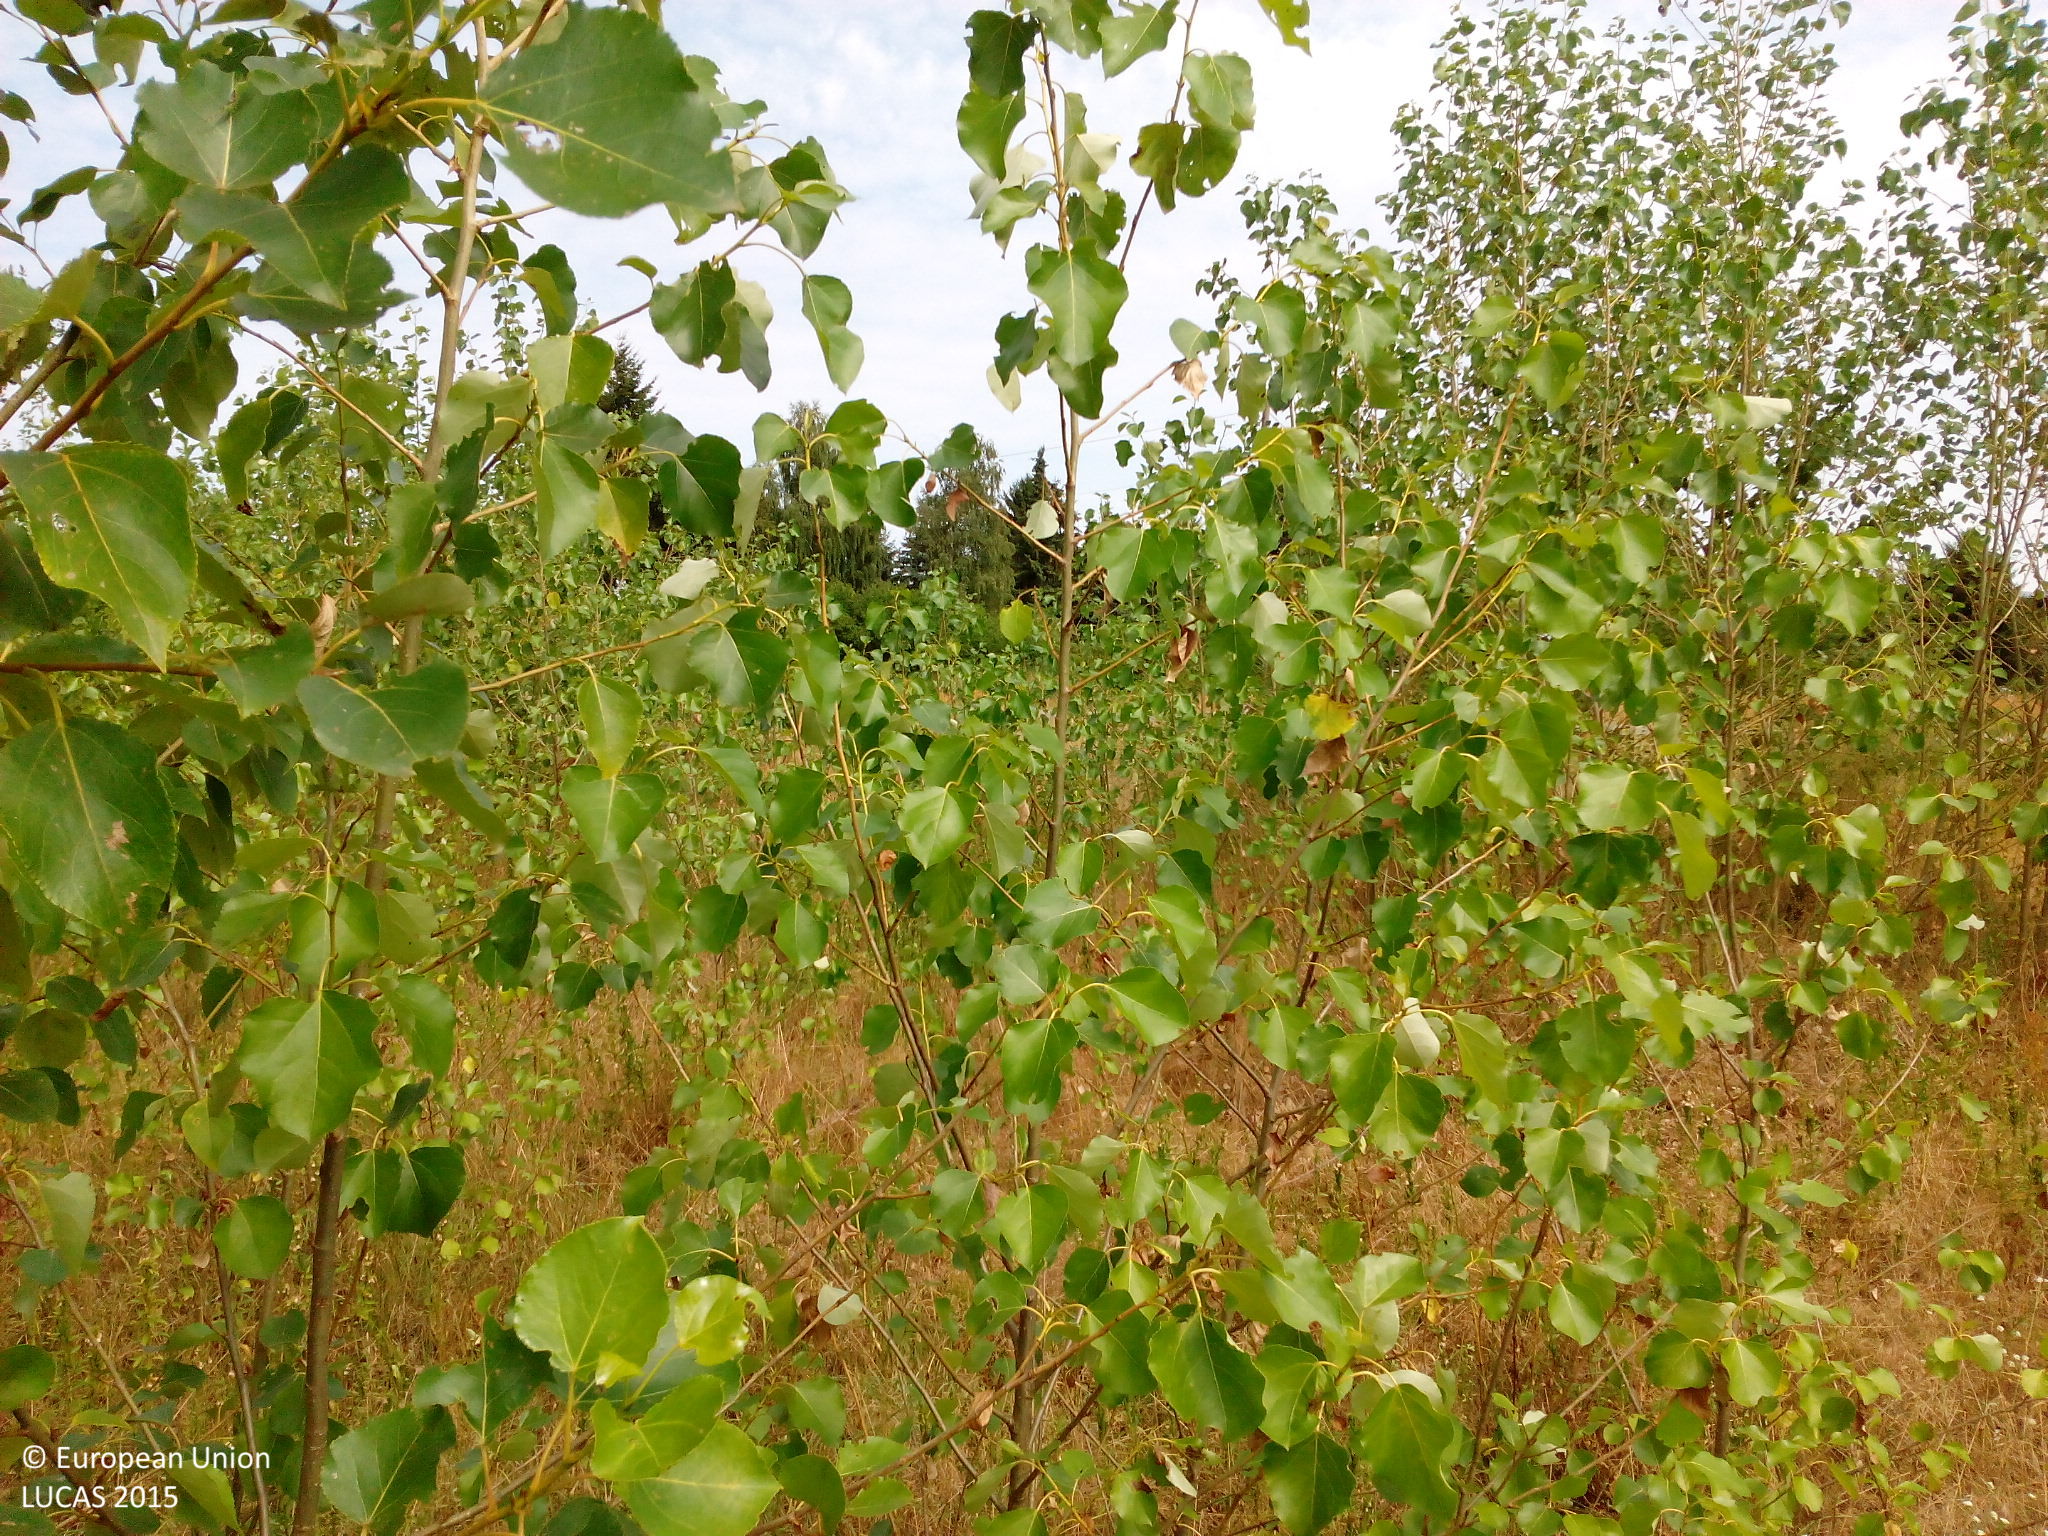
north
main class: Woodland
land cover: Broadleaved woodland
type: mesophytic deciduous forest
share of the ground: 25 - 50 %
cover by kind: broadleaved forest trees 50 %, herbaceous plants 50 %
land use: Semi-natural and natural areas not in use
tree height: < 5 m
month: August
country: DE
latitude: 52.6767
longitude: 13.1798
